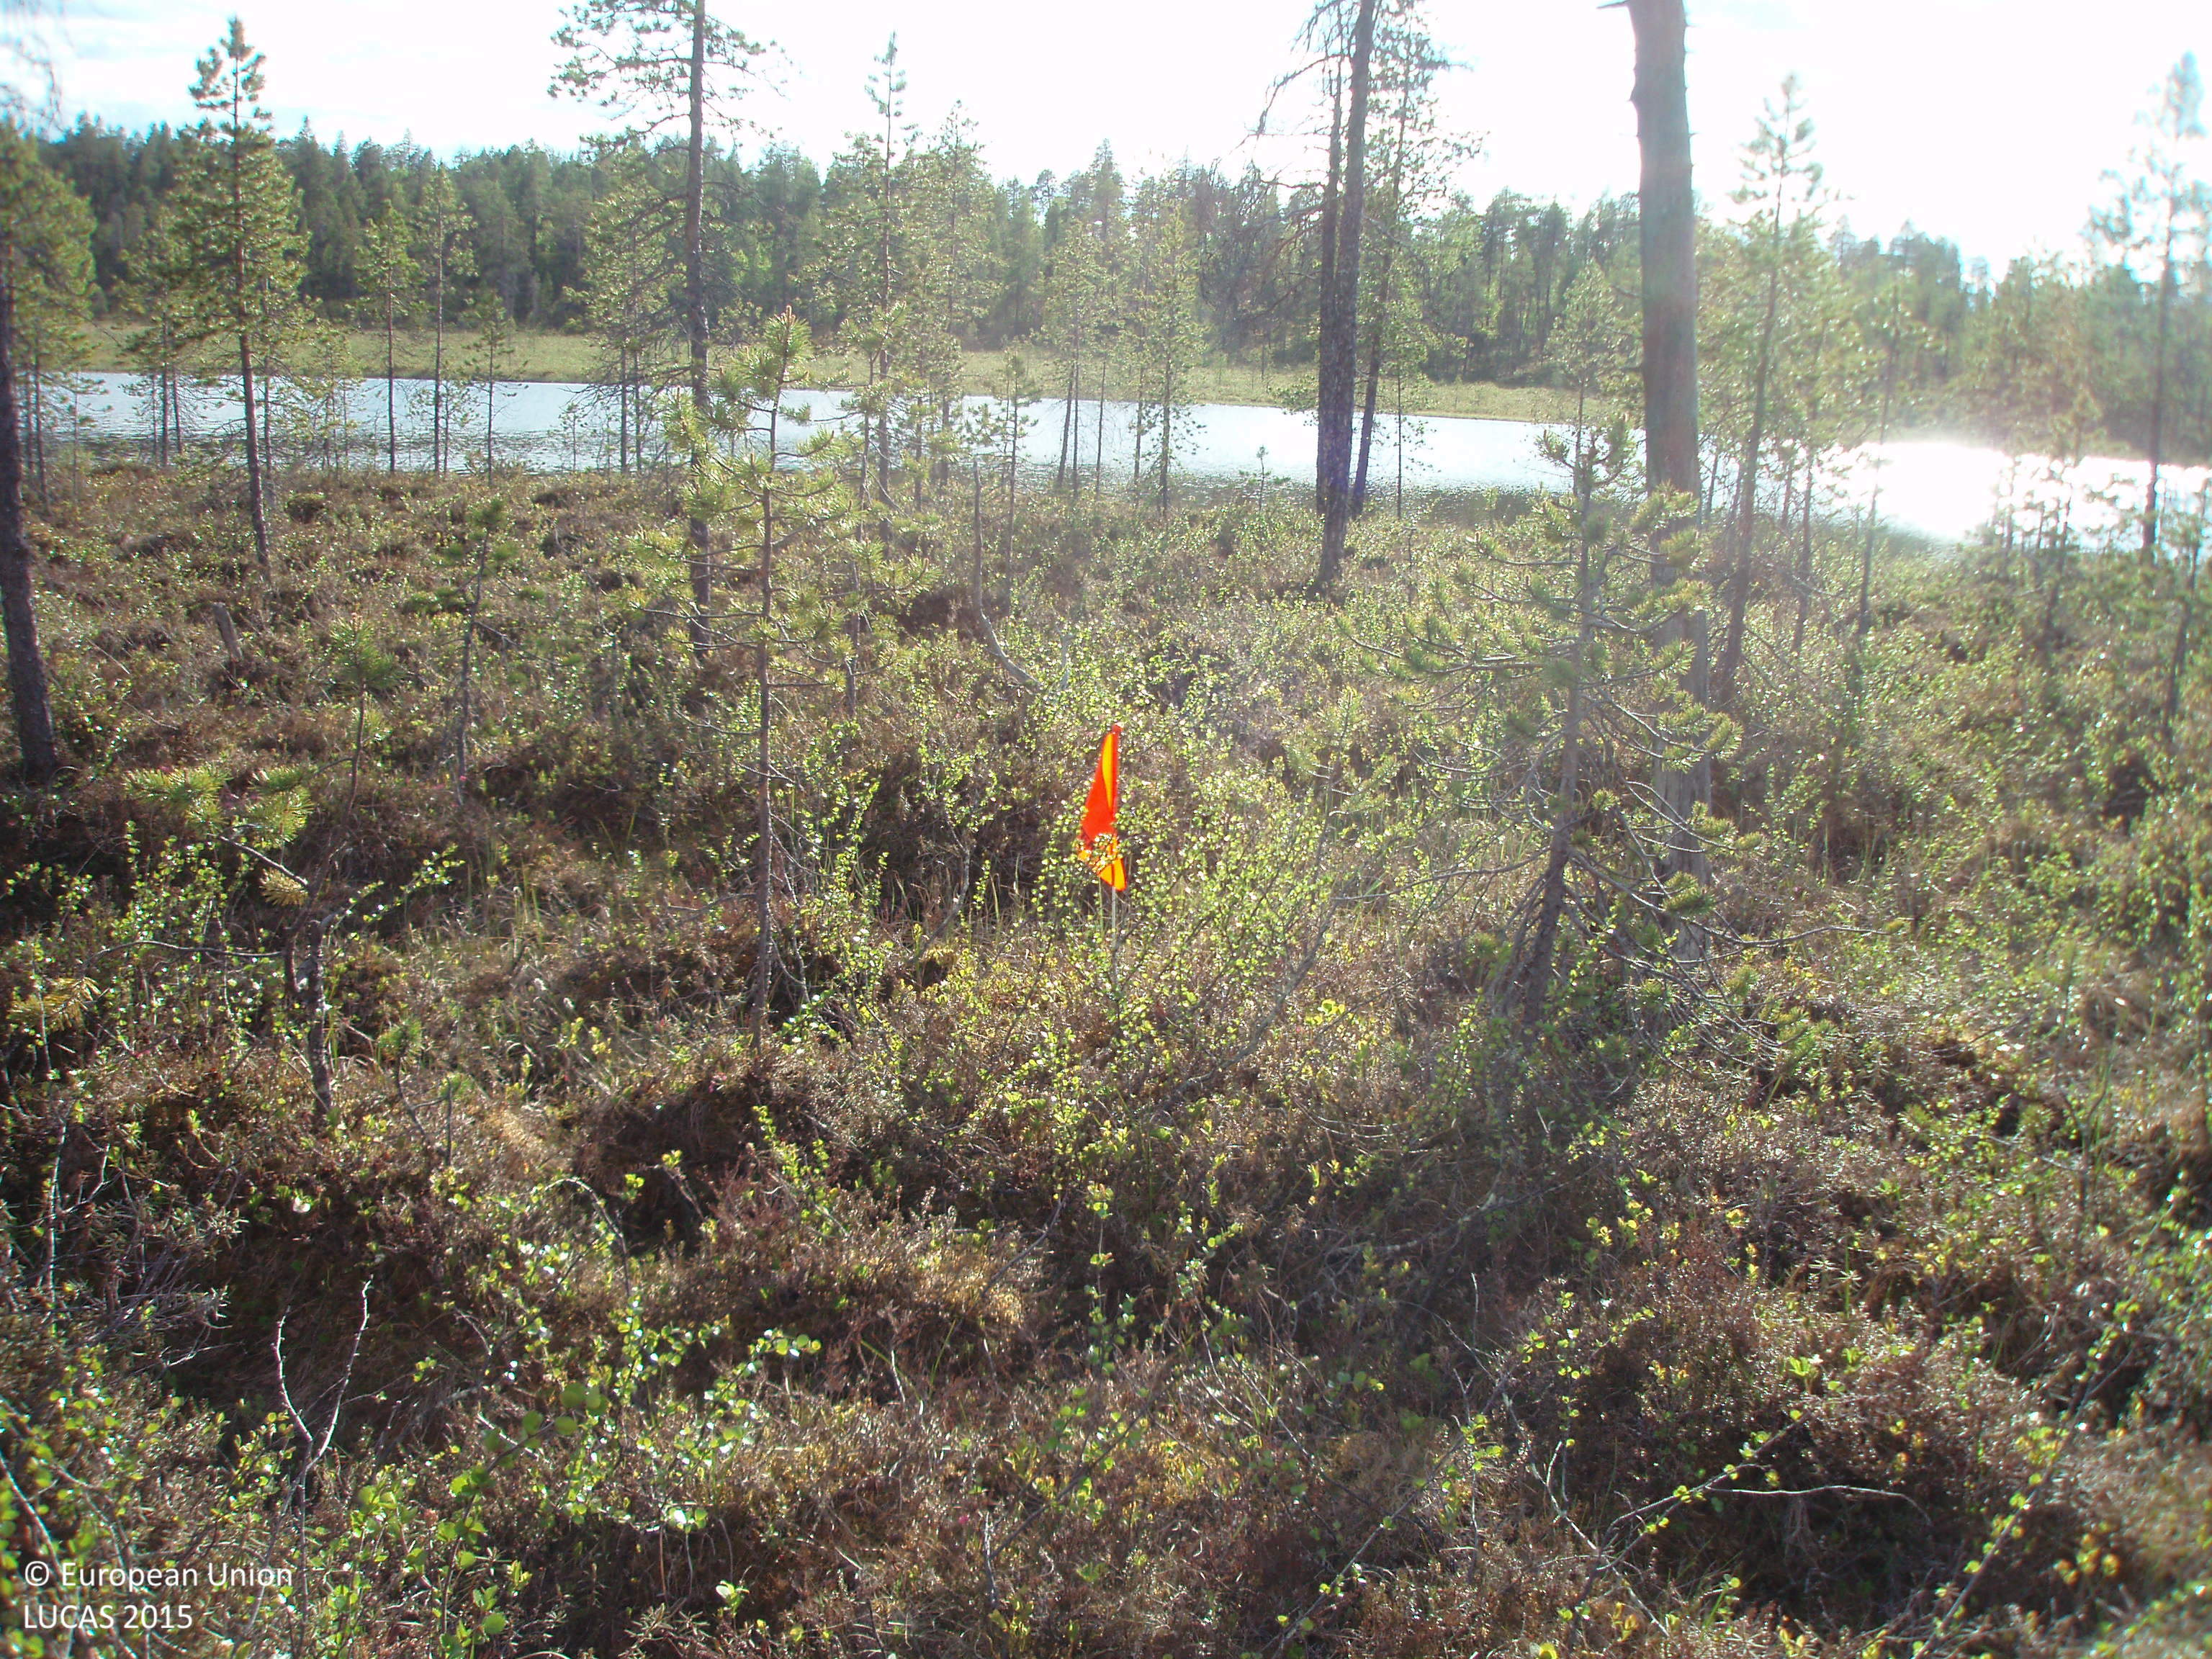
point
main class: Woodland
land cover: Pine dominated coniferous woodland
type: boreal forest
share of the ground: 25 - 50 %
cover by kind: shrubs 60 %, coniferous forest trees 30 %, lichens and mosses 10 %
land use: Semi-natural and natural areas not in use
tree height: > 5 m
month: June
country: FI
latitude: 68.7625
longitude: 28.5350
